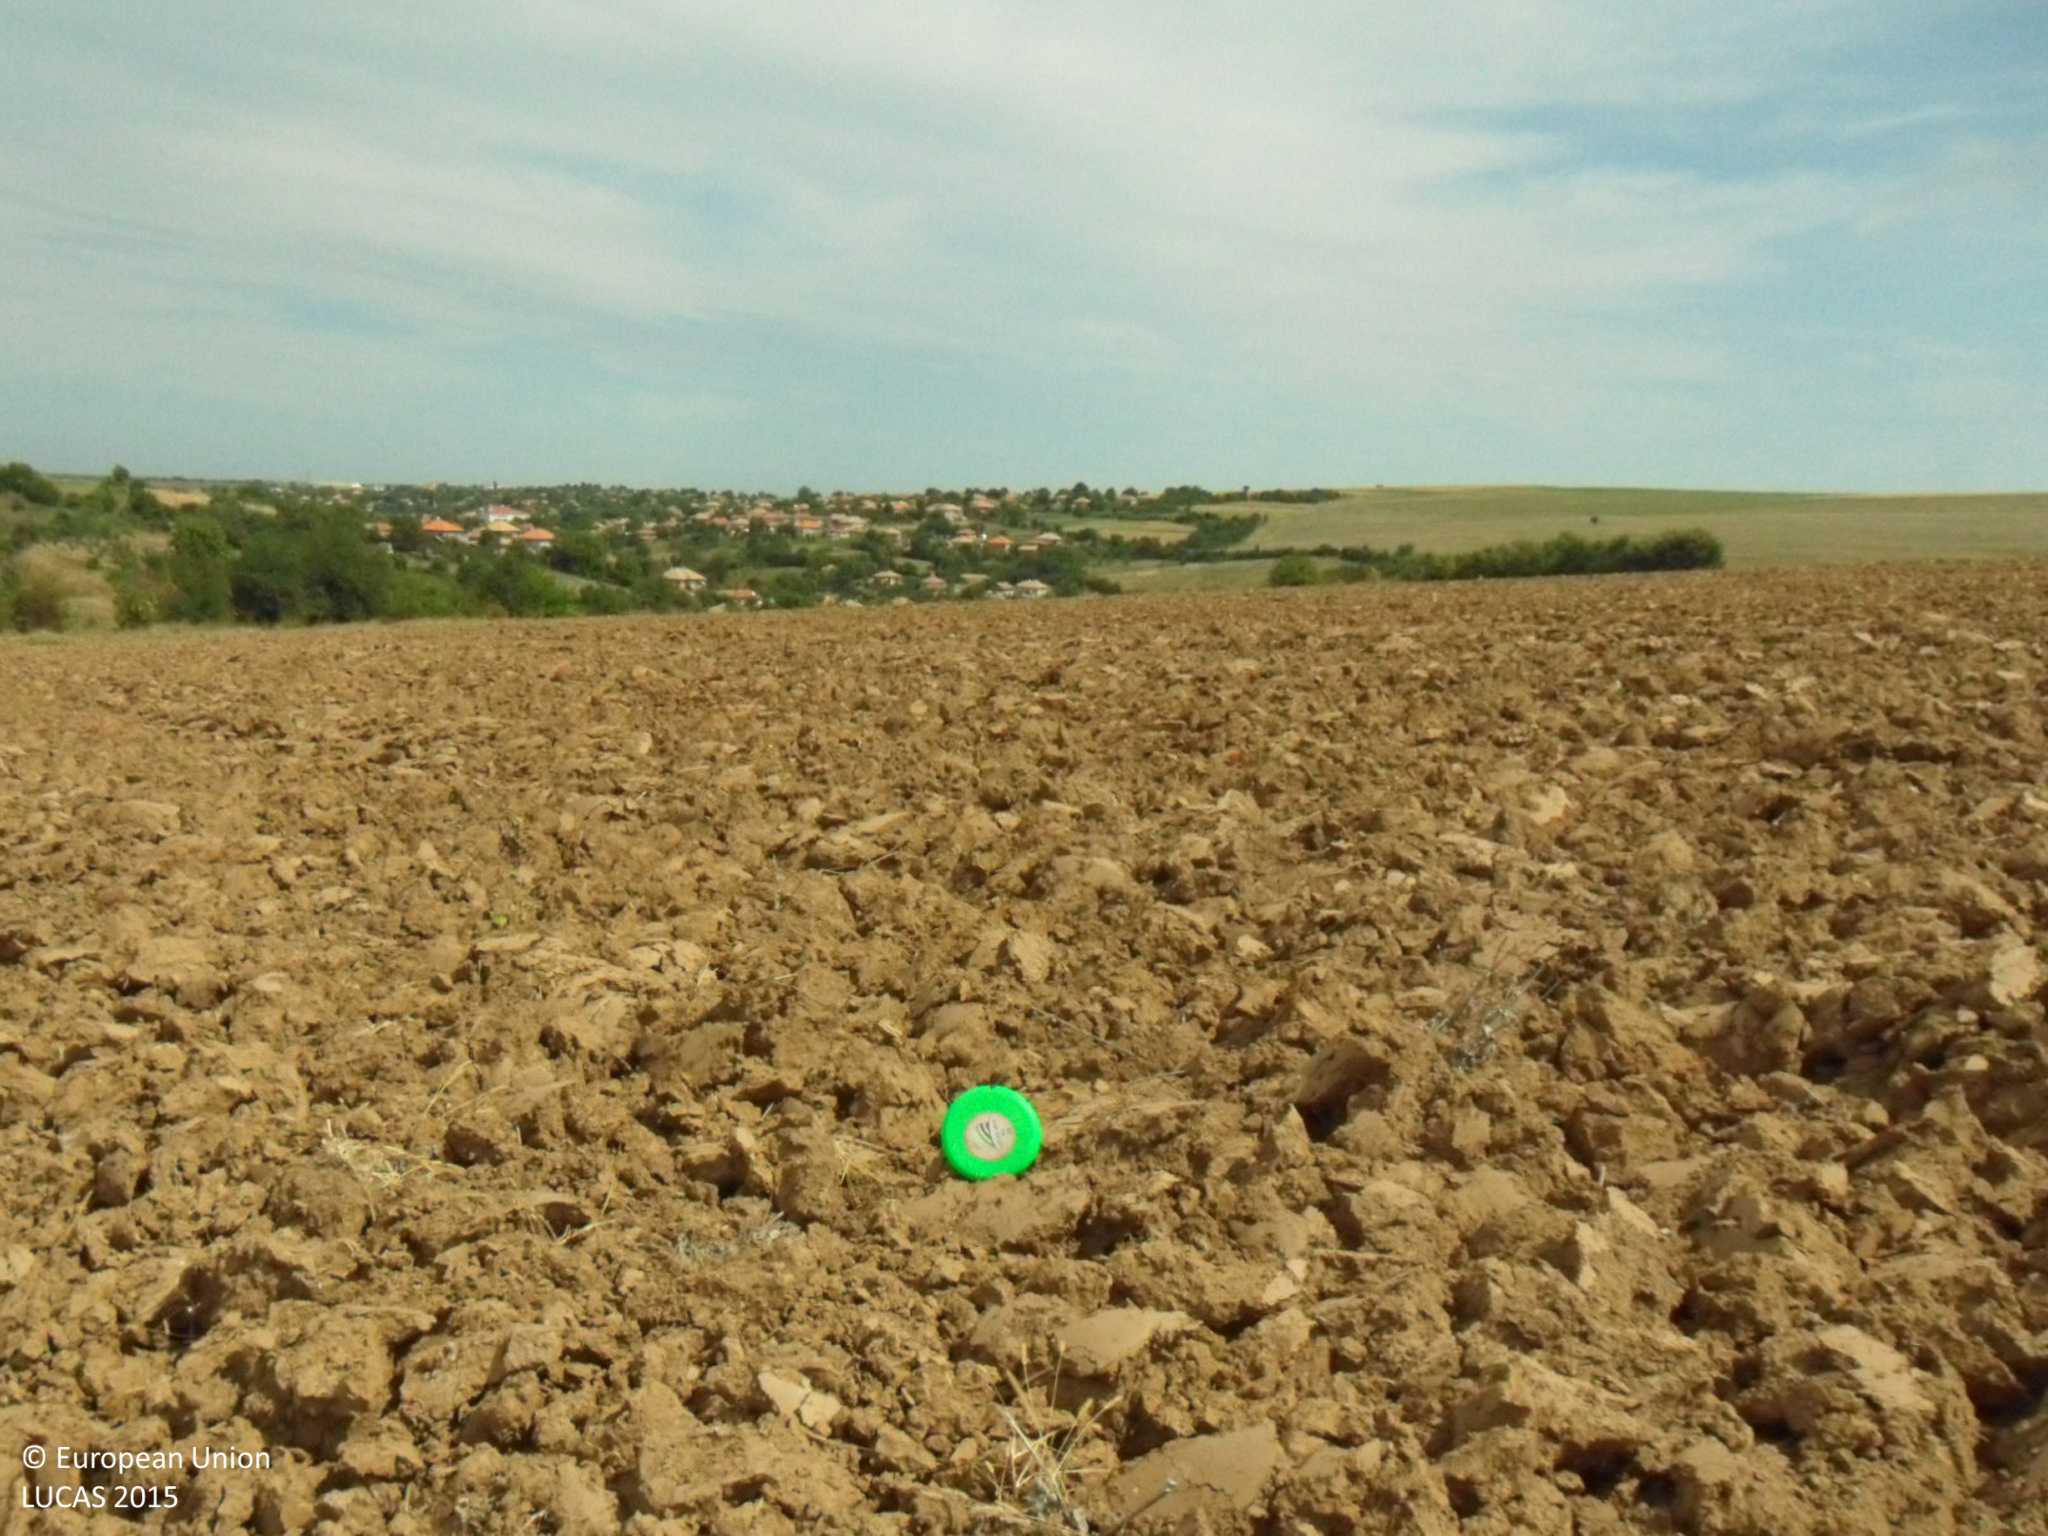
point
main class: Cropland
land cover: Common wheat
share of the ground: < 10 %
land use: Agriculture (excluding fallow land and kitchen gardens)
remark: Harvested field
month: September
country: BG
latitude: 43.5470
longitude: 26.3019
